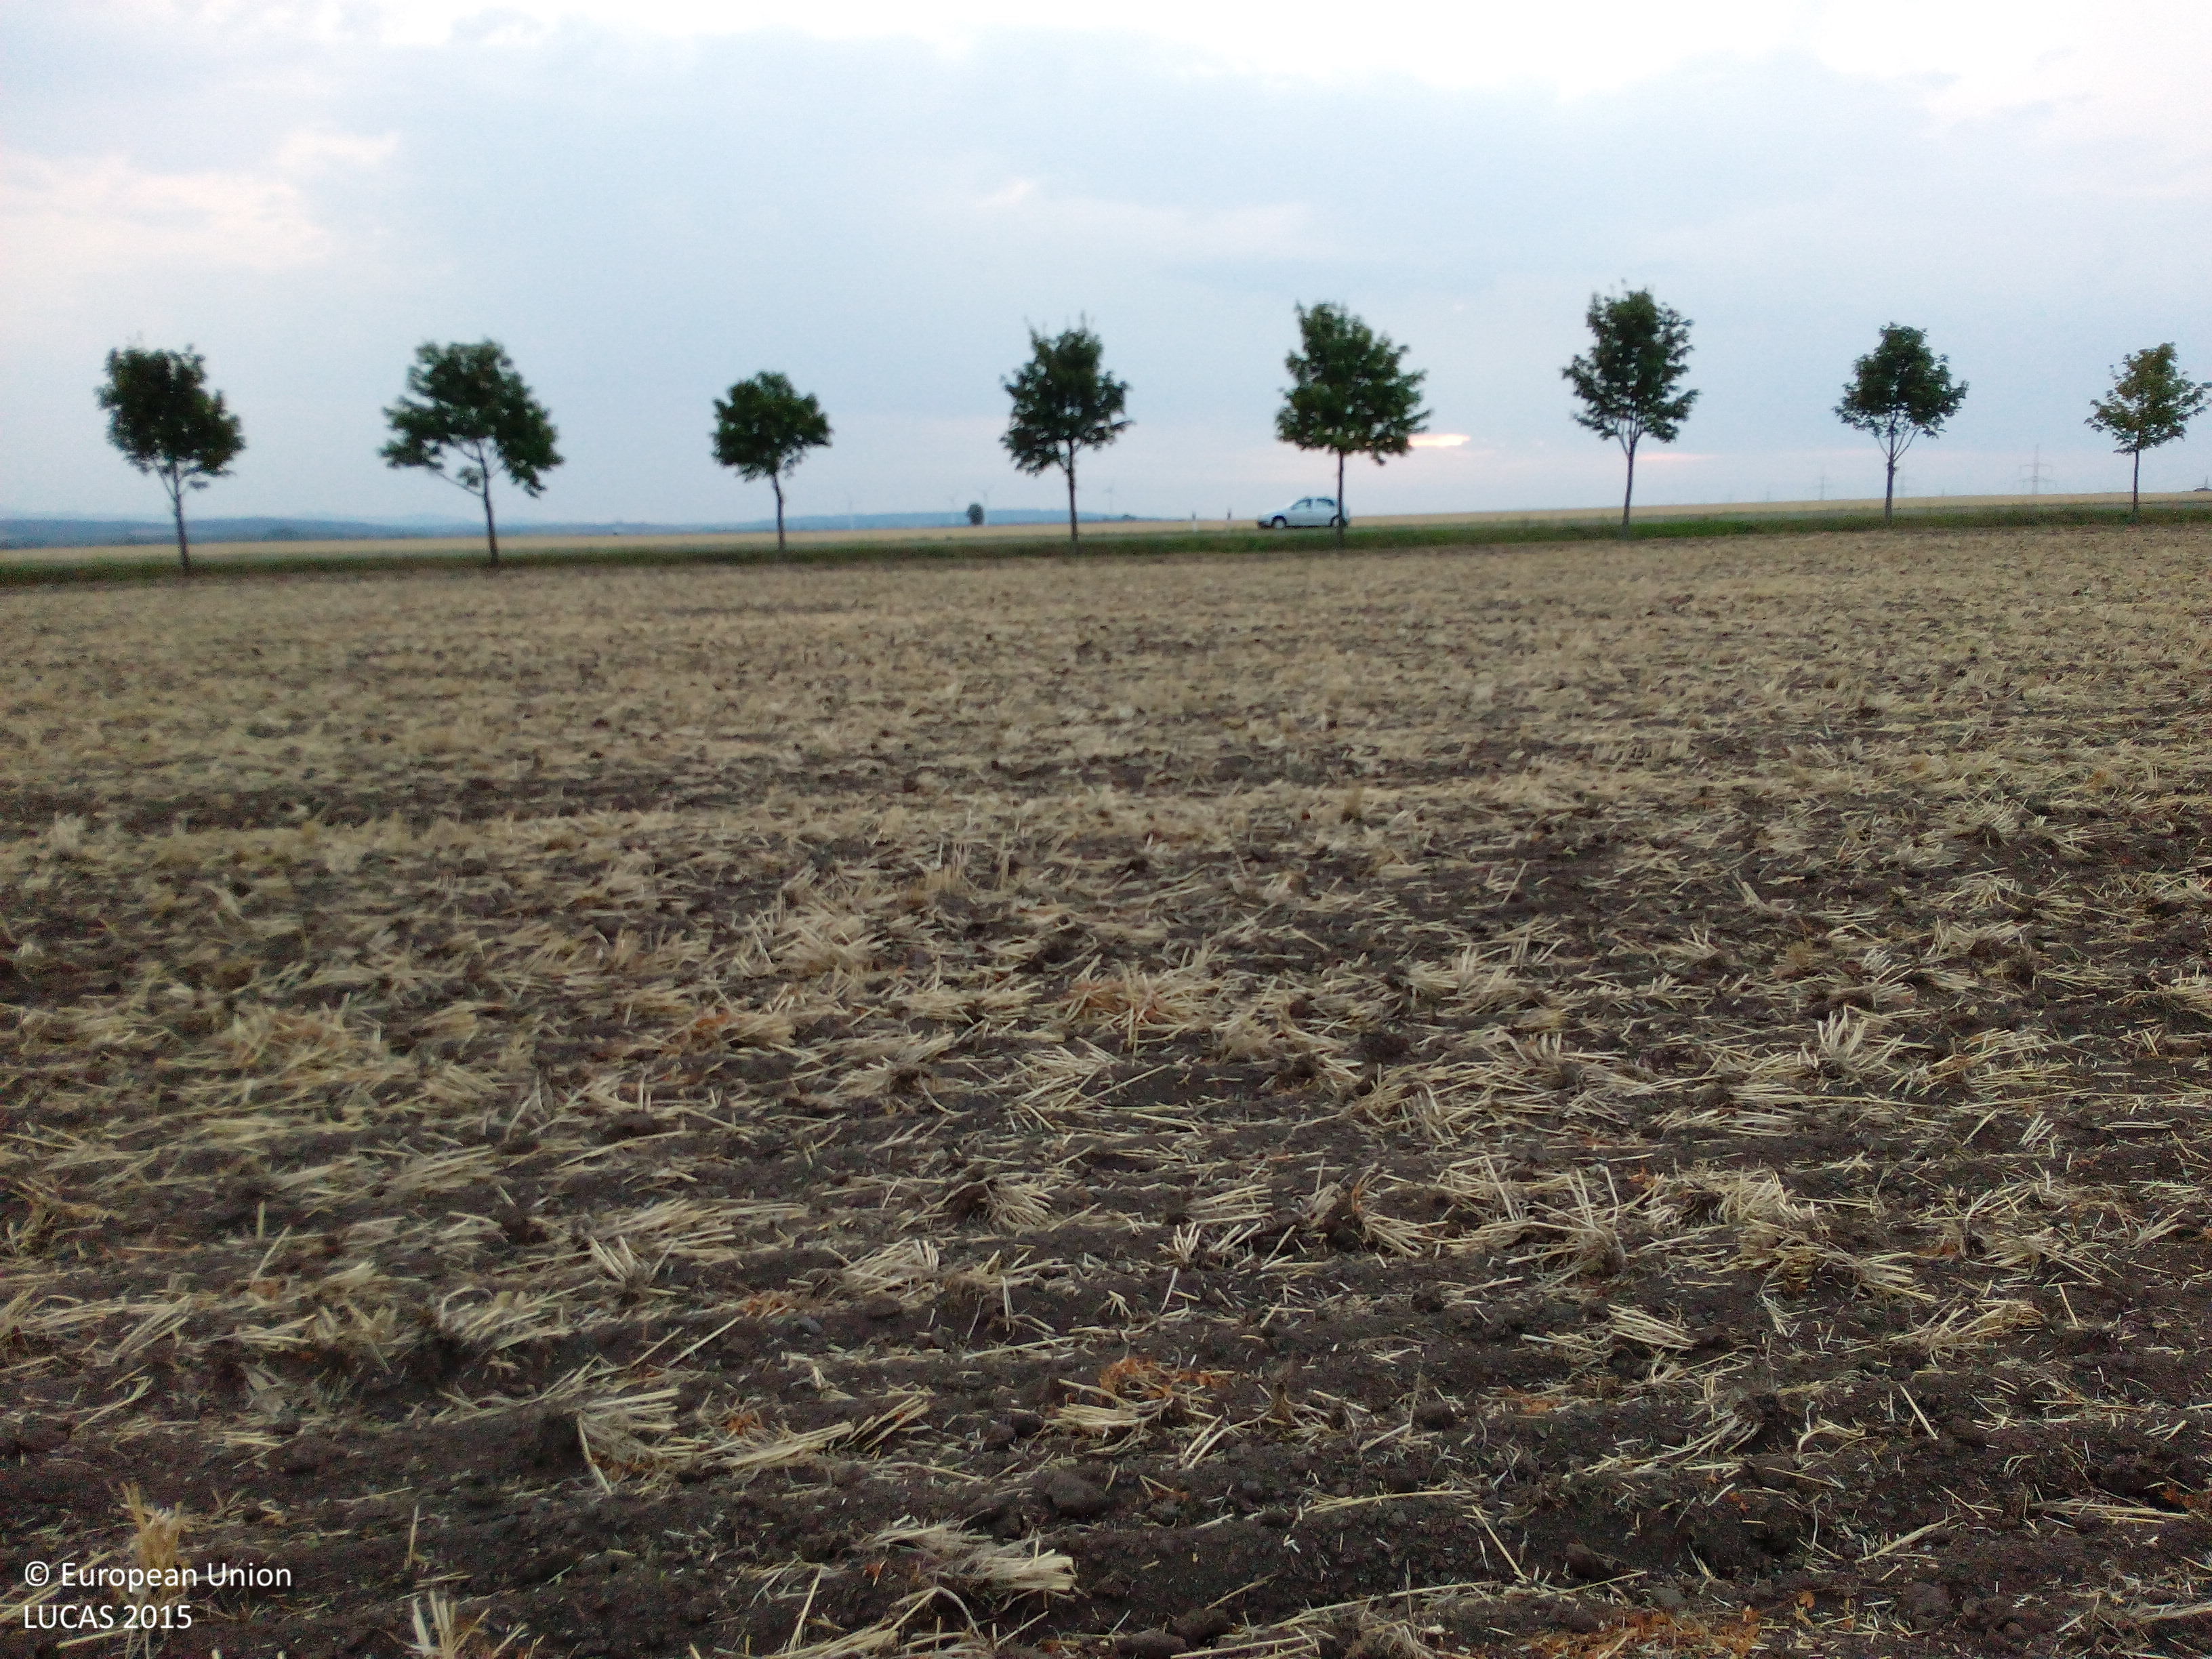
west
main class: Cropland
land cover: Common wheat
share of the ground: < 10 %
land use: Agriculture (excluding fallow land and kitchen gardens)
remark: Harvested field
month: August
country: DE
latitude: 50.9543
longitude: 10.8397
